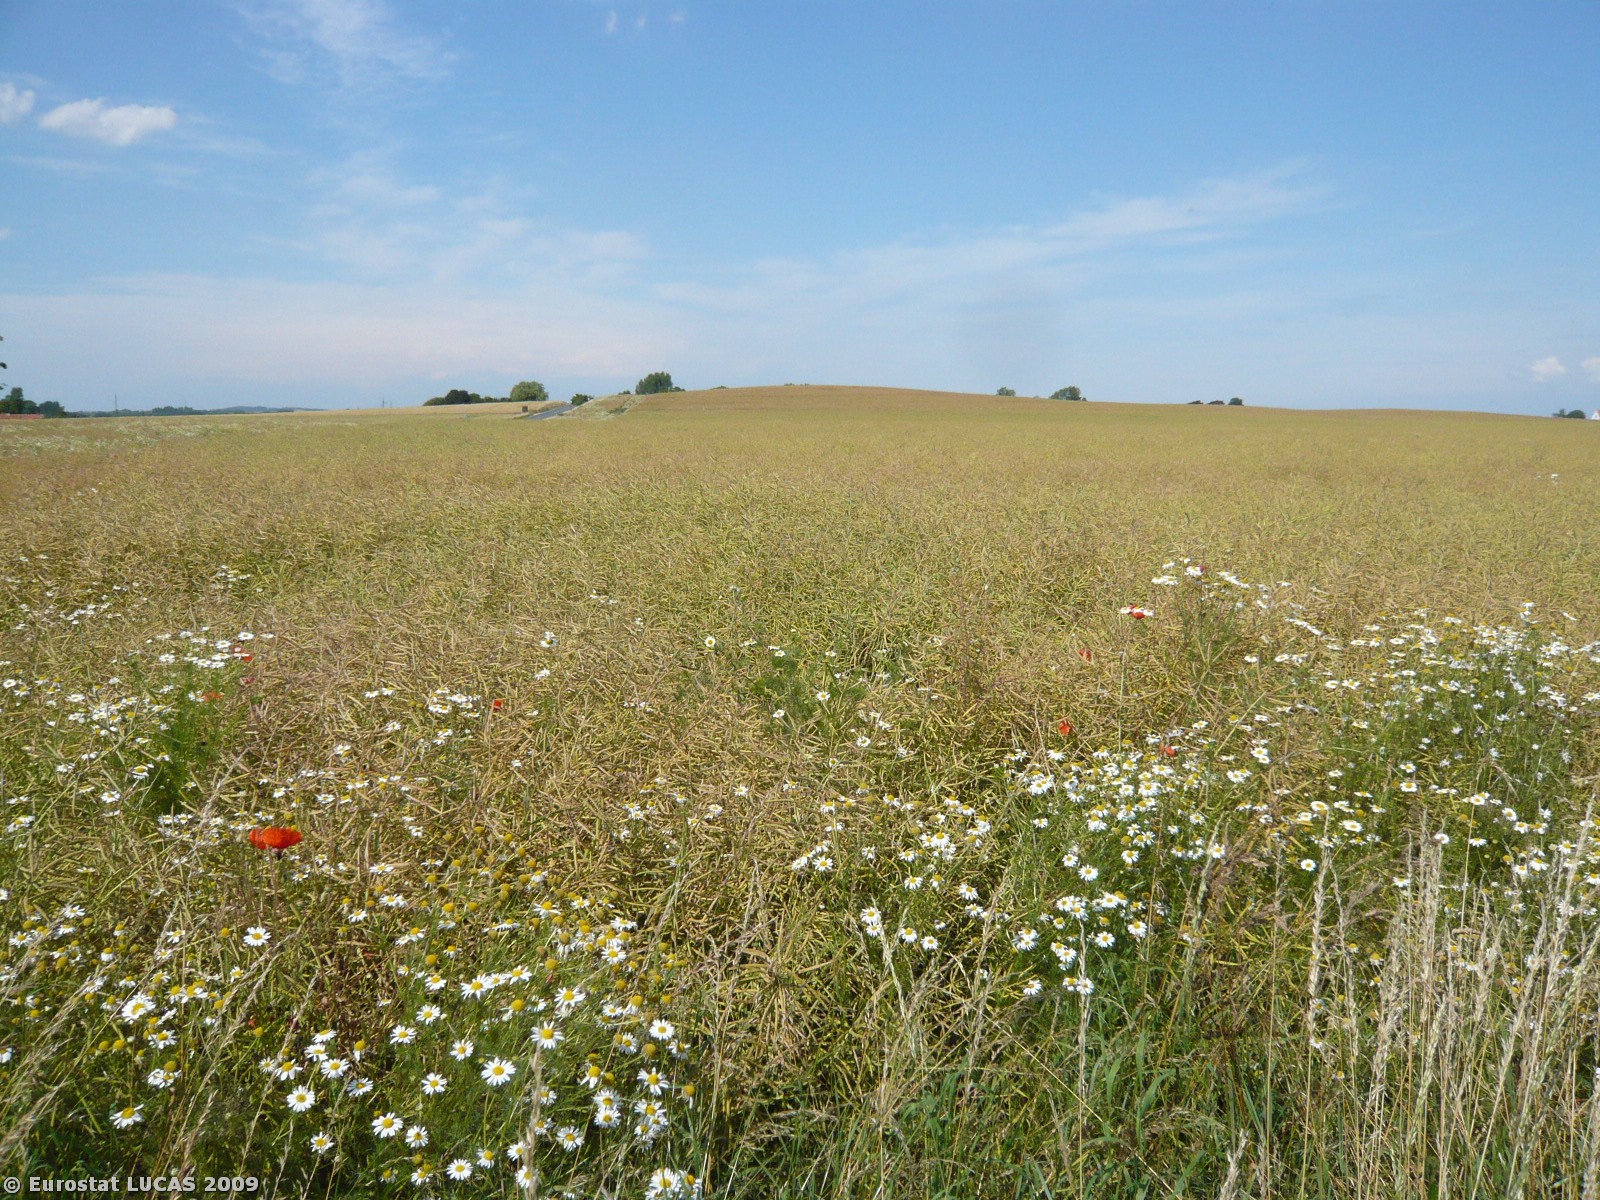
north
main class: Cropland
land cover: Rape and turnip rape
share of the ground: > 75 %
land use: Agriculture (excluding fallow land and kitchen gardens)
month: July
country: DK
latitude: 55.6938
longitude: 11.4781
